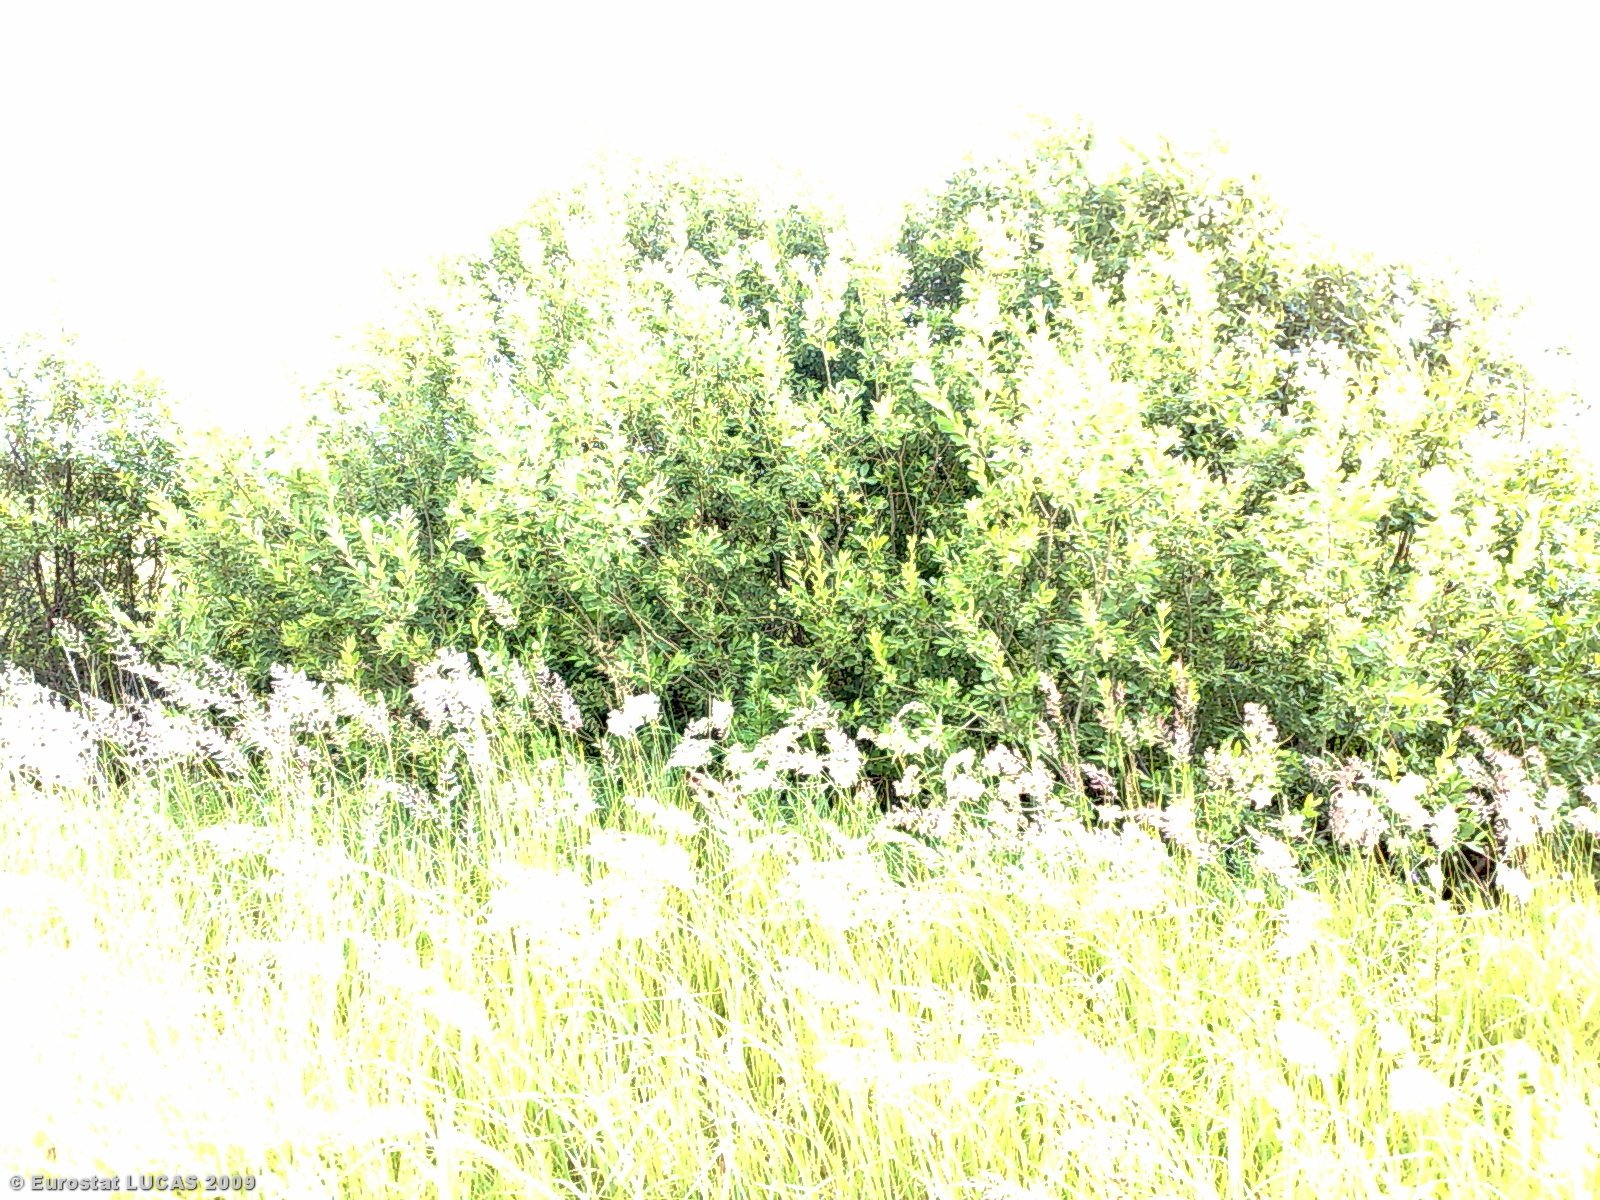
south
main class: Cropland
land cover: Rye
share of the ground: > 75 %
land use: Agriculture (excluding fallow land and kitchen gardens)
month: July
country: LT
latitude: 56.1471
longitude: 22.9594
